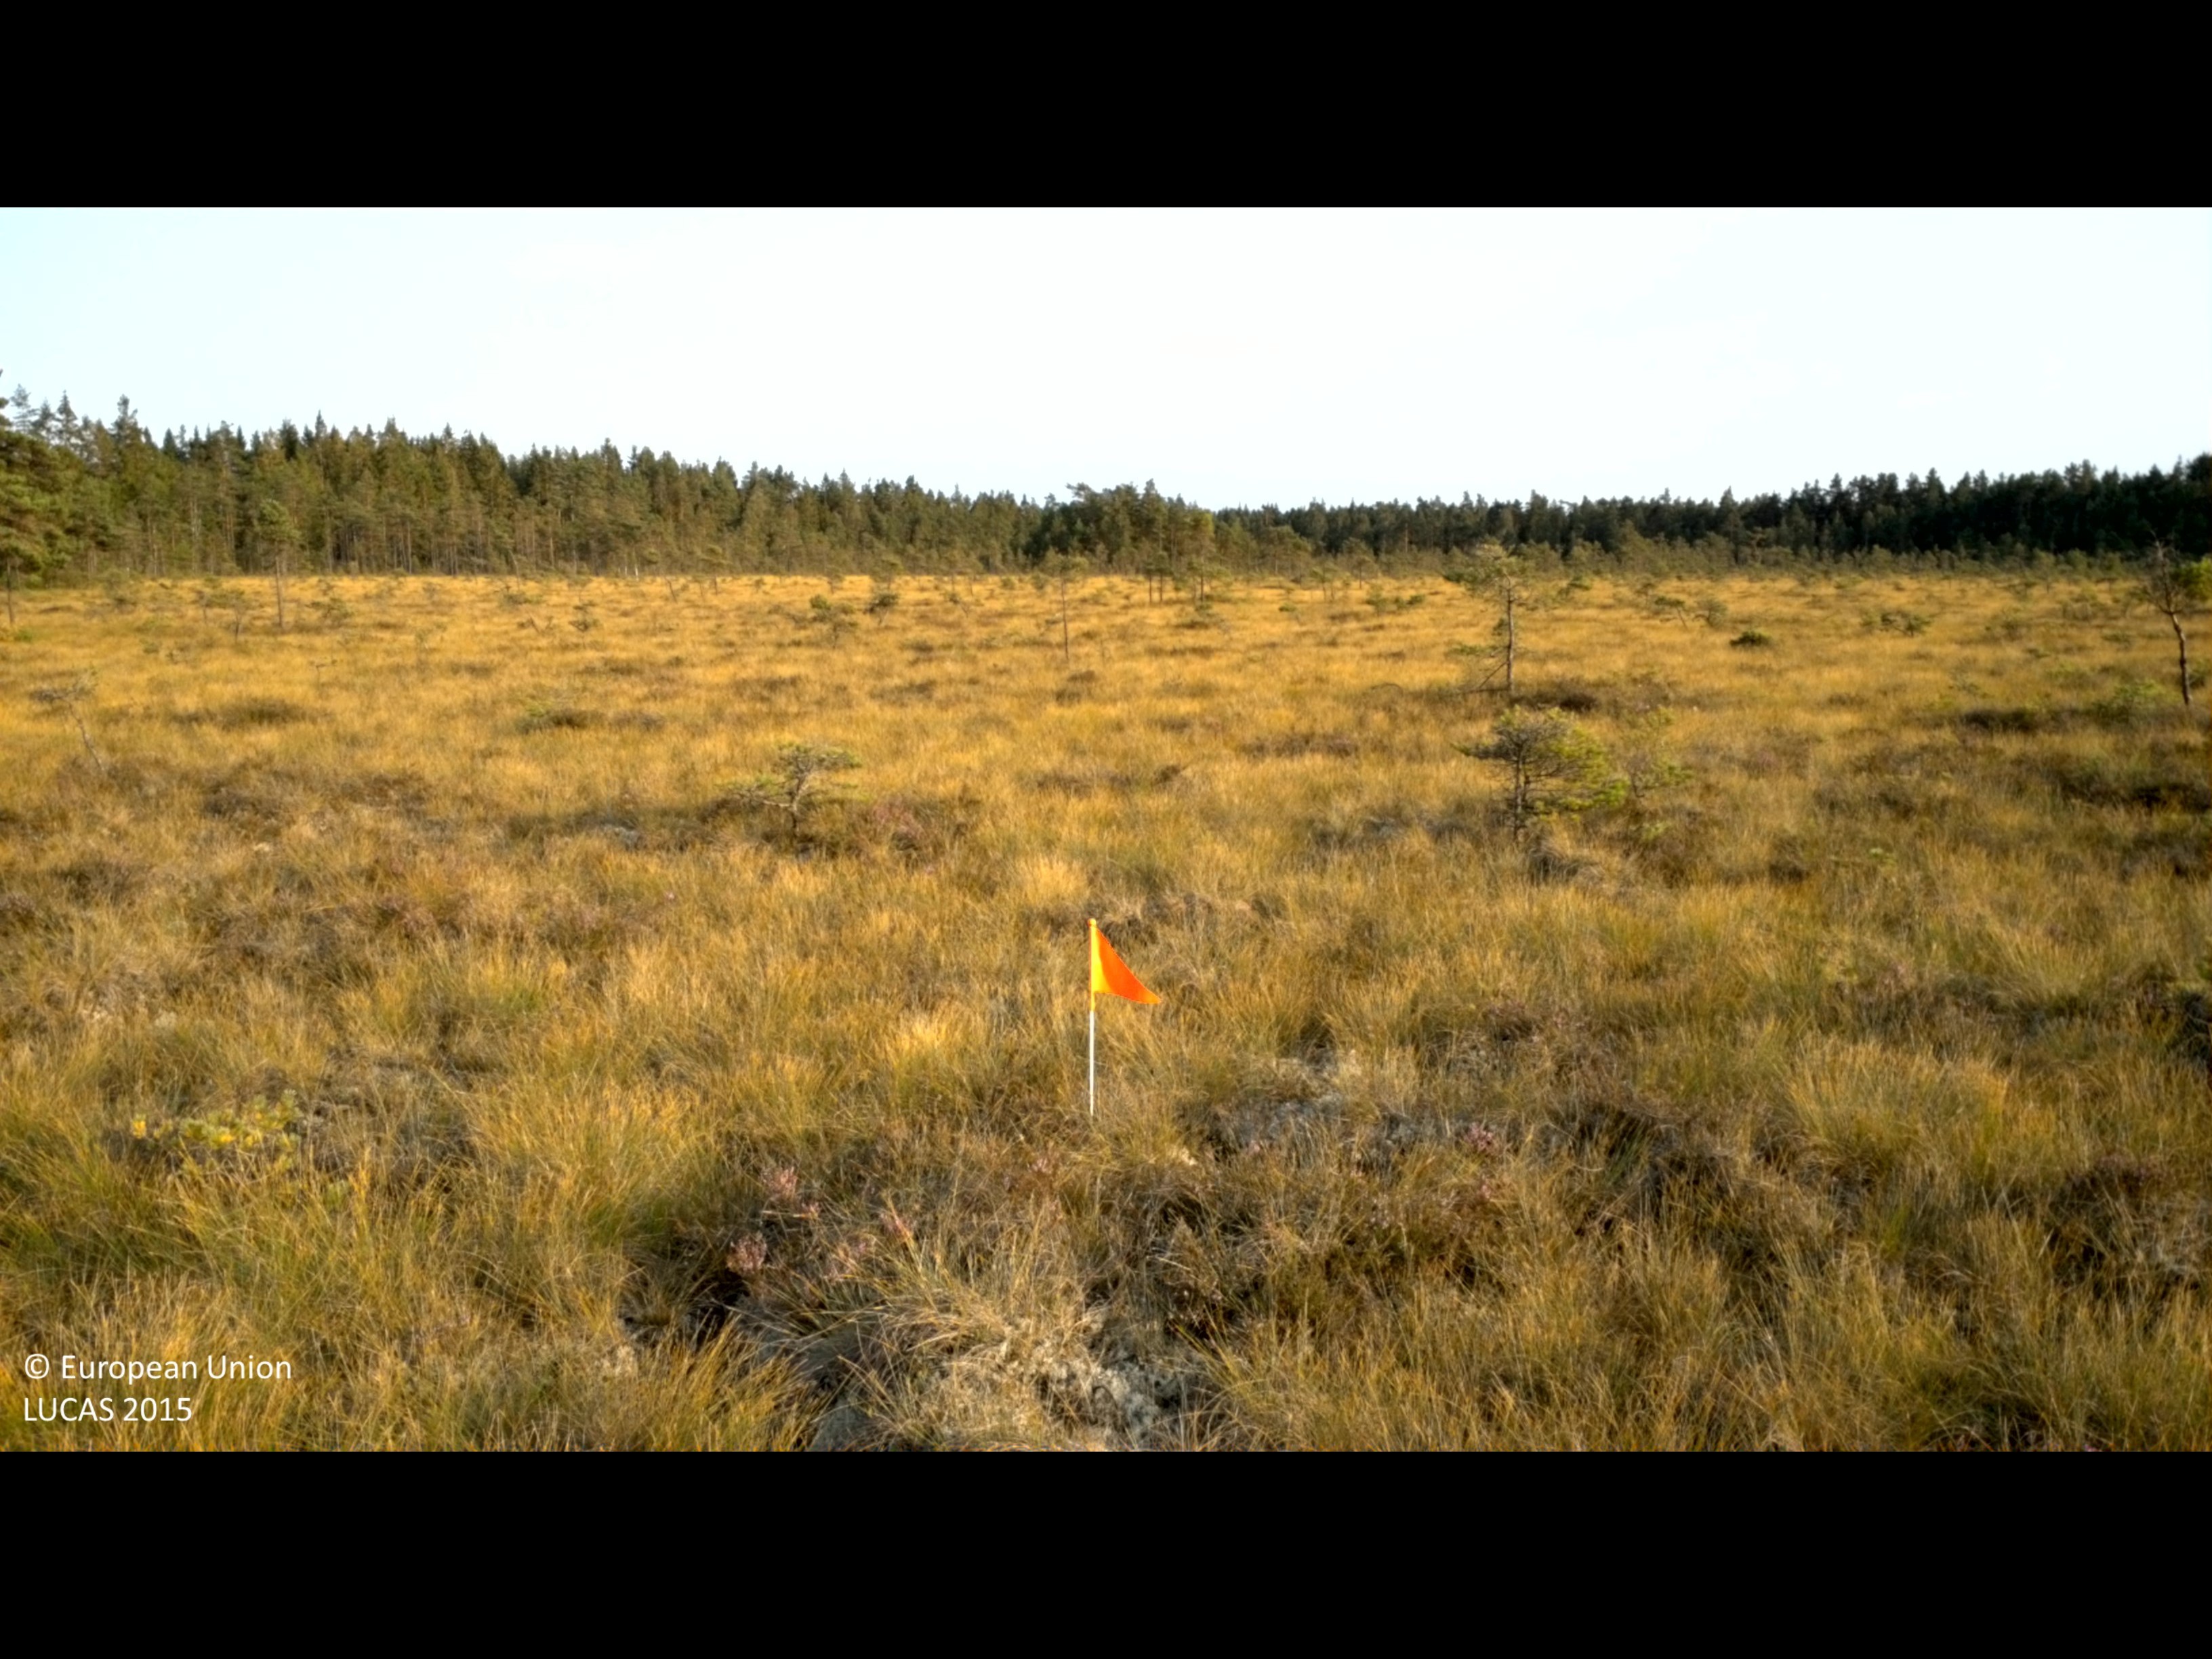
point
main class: Woodland
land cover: Pine dominated coniferous woodland
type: mire and swamp forests
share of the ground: 10 - 25 %
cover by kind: herbaceous plants 55 %, shrubs 20 %, coniferous forest trees 15 %, lichens and mosses 10 %
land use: Semi-natural and natural areas not in use
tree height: < 5 m
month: August
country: SE
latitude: 56.8969
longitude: 14.0845
